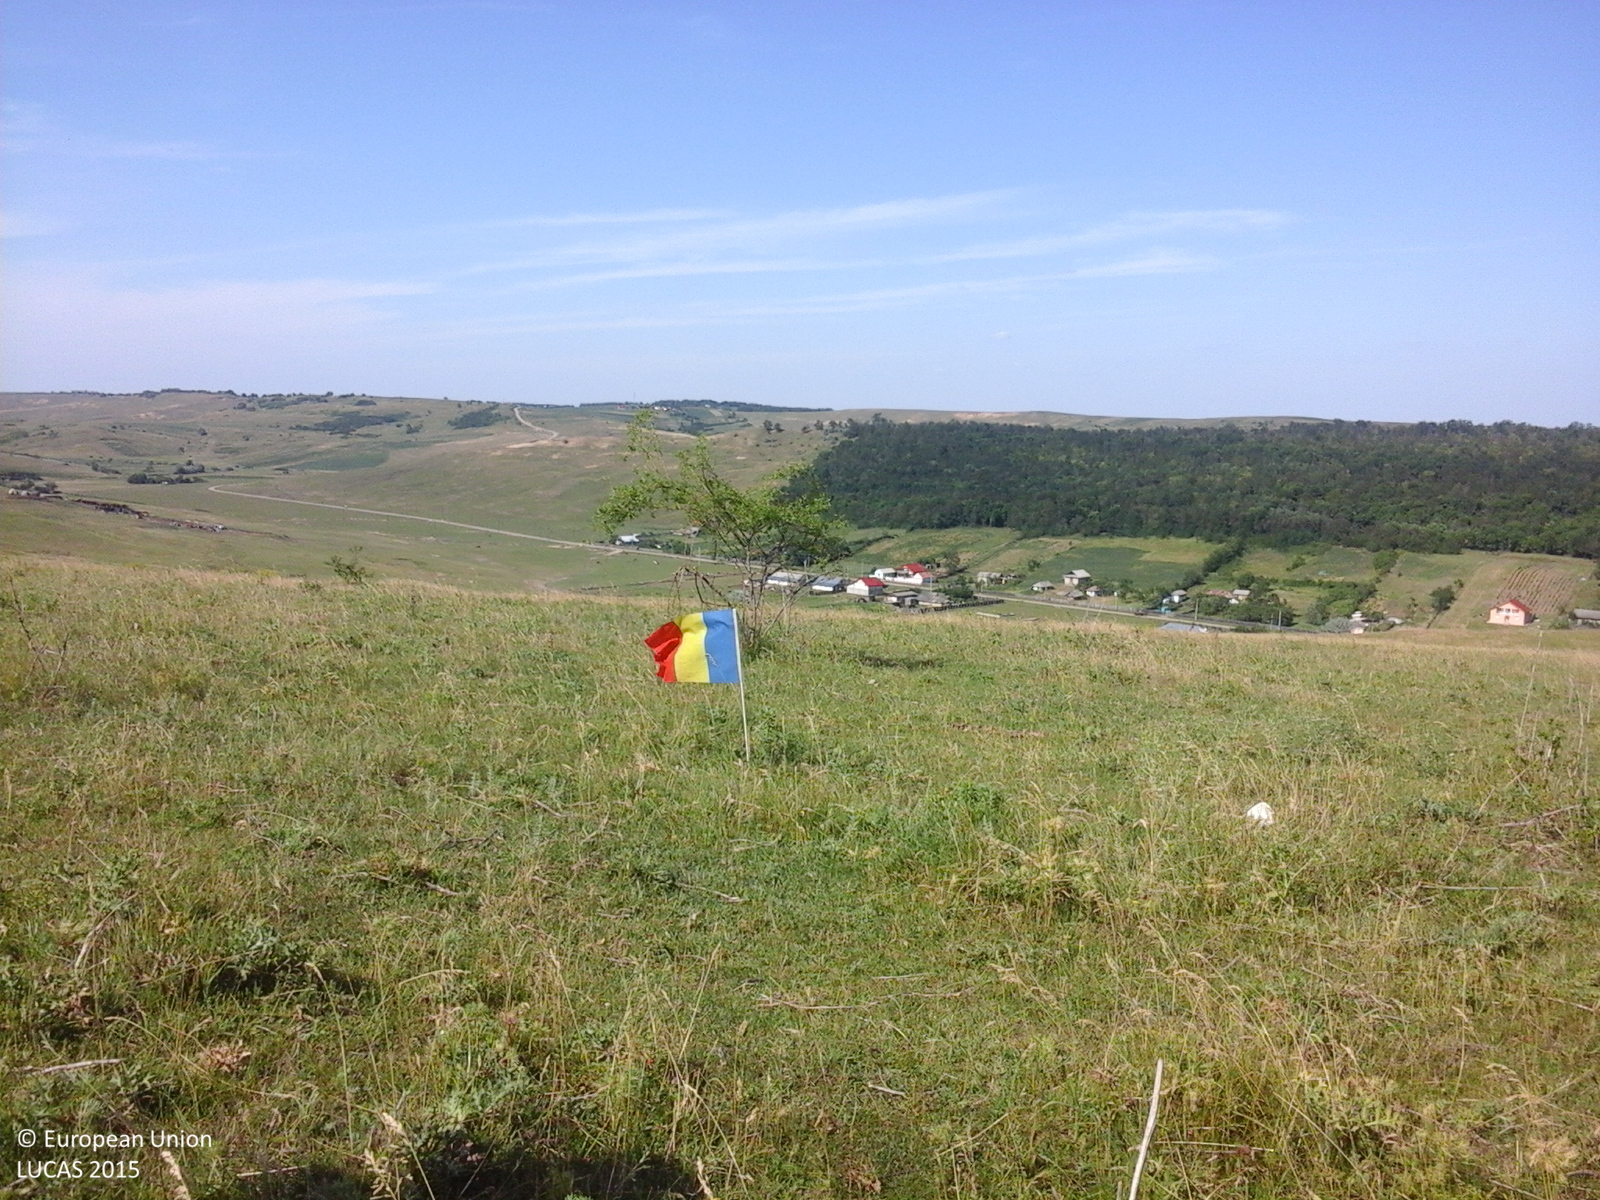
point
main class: Grassland
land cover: Grassland without tree/shrub cover
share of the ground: > 75 %
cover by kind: herbaceous plants 100 %
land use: Agriculture (excluding fallow land and kitchen gardens)
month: June
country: RO
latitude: 47.1187
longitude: 27.0654
